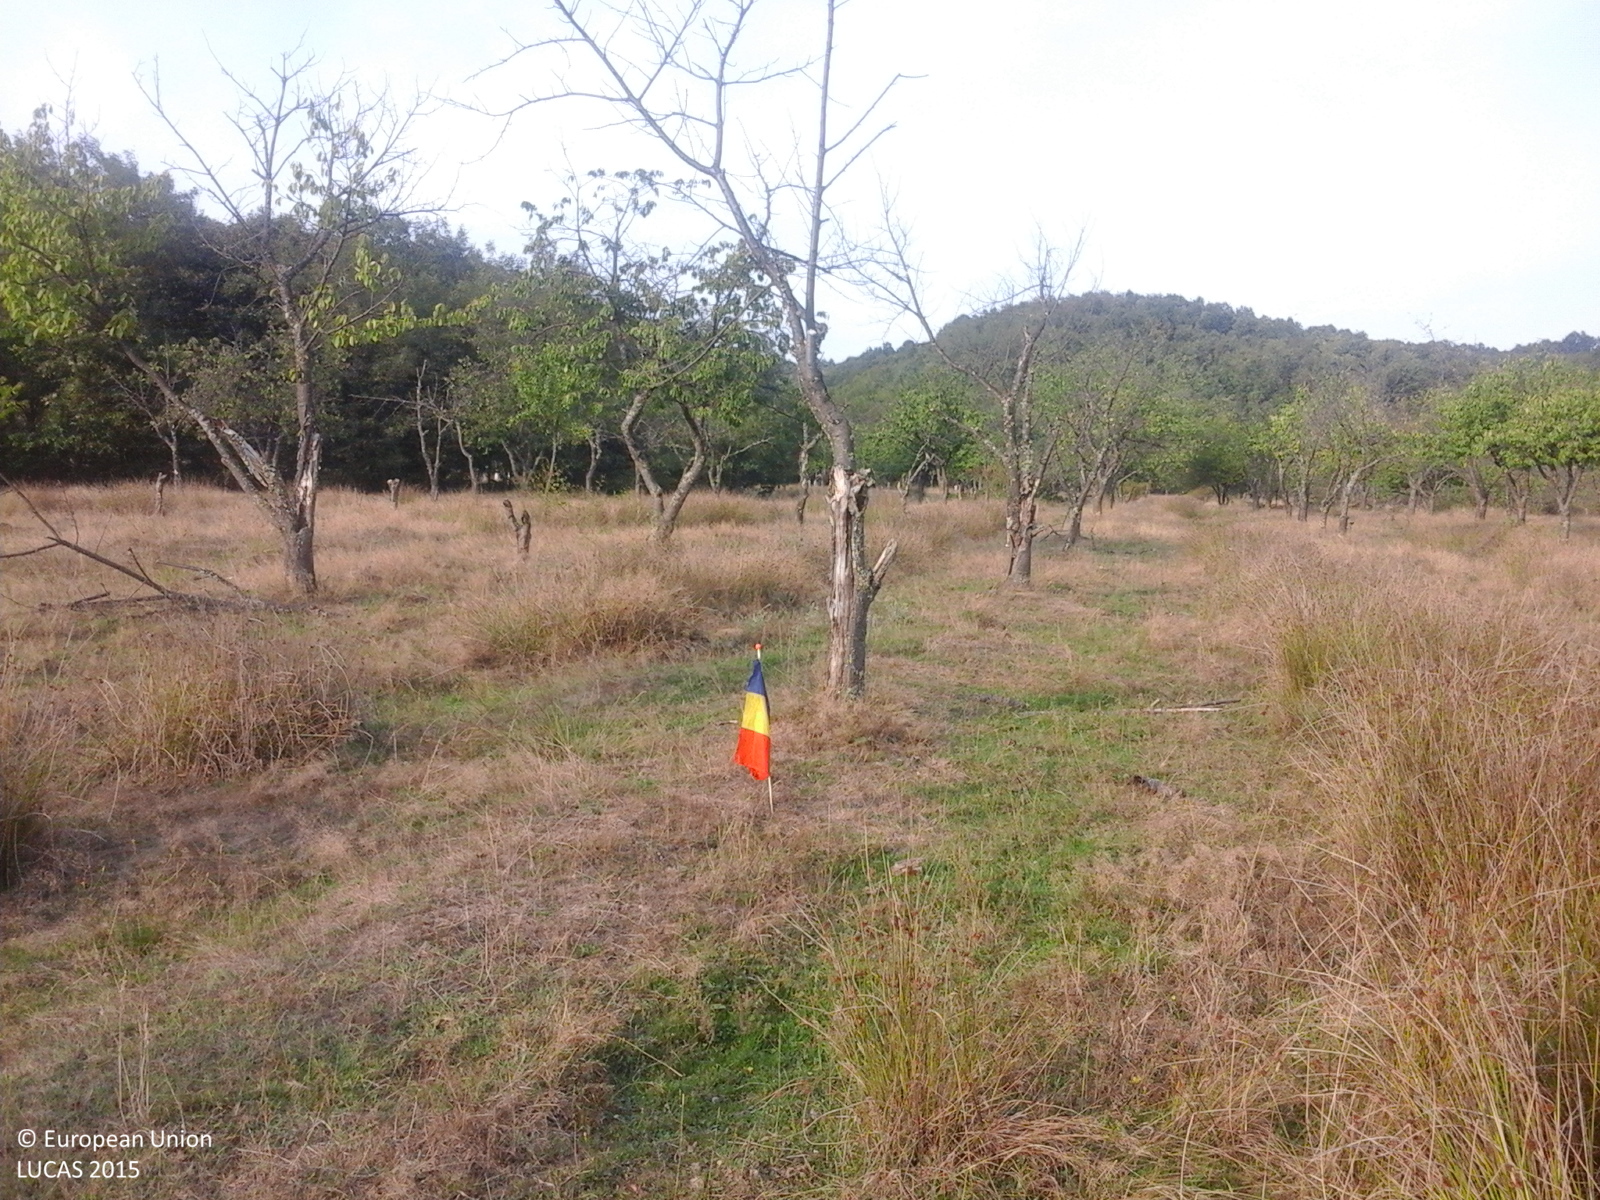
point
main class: Cropland
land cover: Cherry fruit
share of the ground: 50 - 75 %
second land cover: Grassland without tree/shrub cover
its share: > 75 %
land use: Agriculture (excluding fallow land and kitchen gardens)
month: September
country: RO
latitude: 45.5205
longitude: 22.2165
